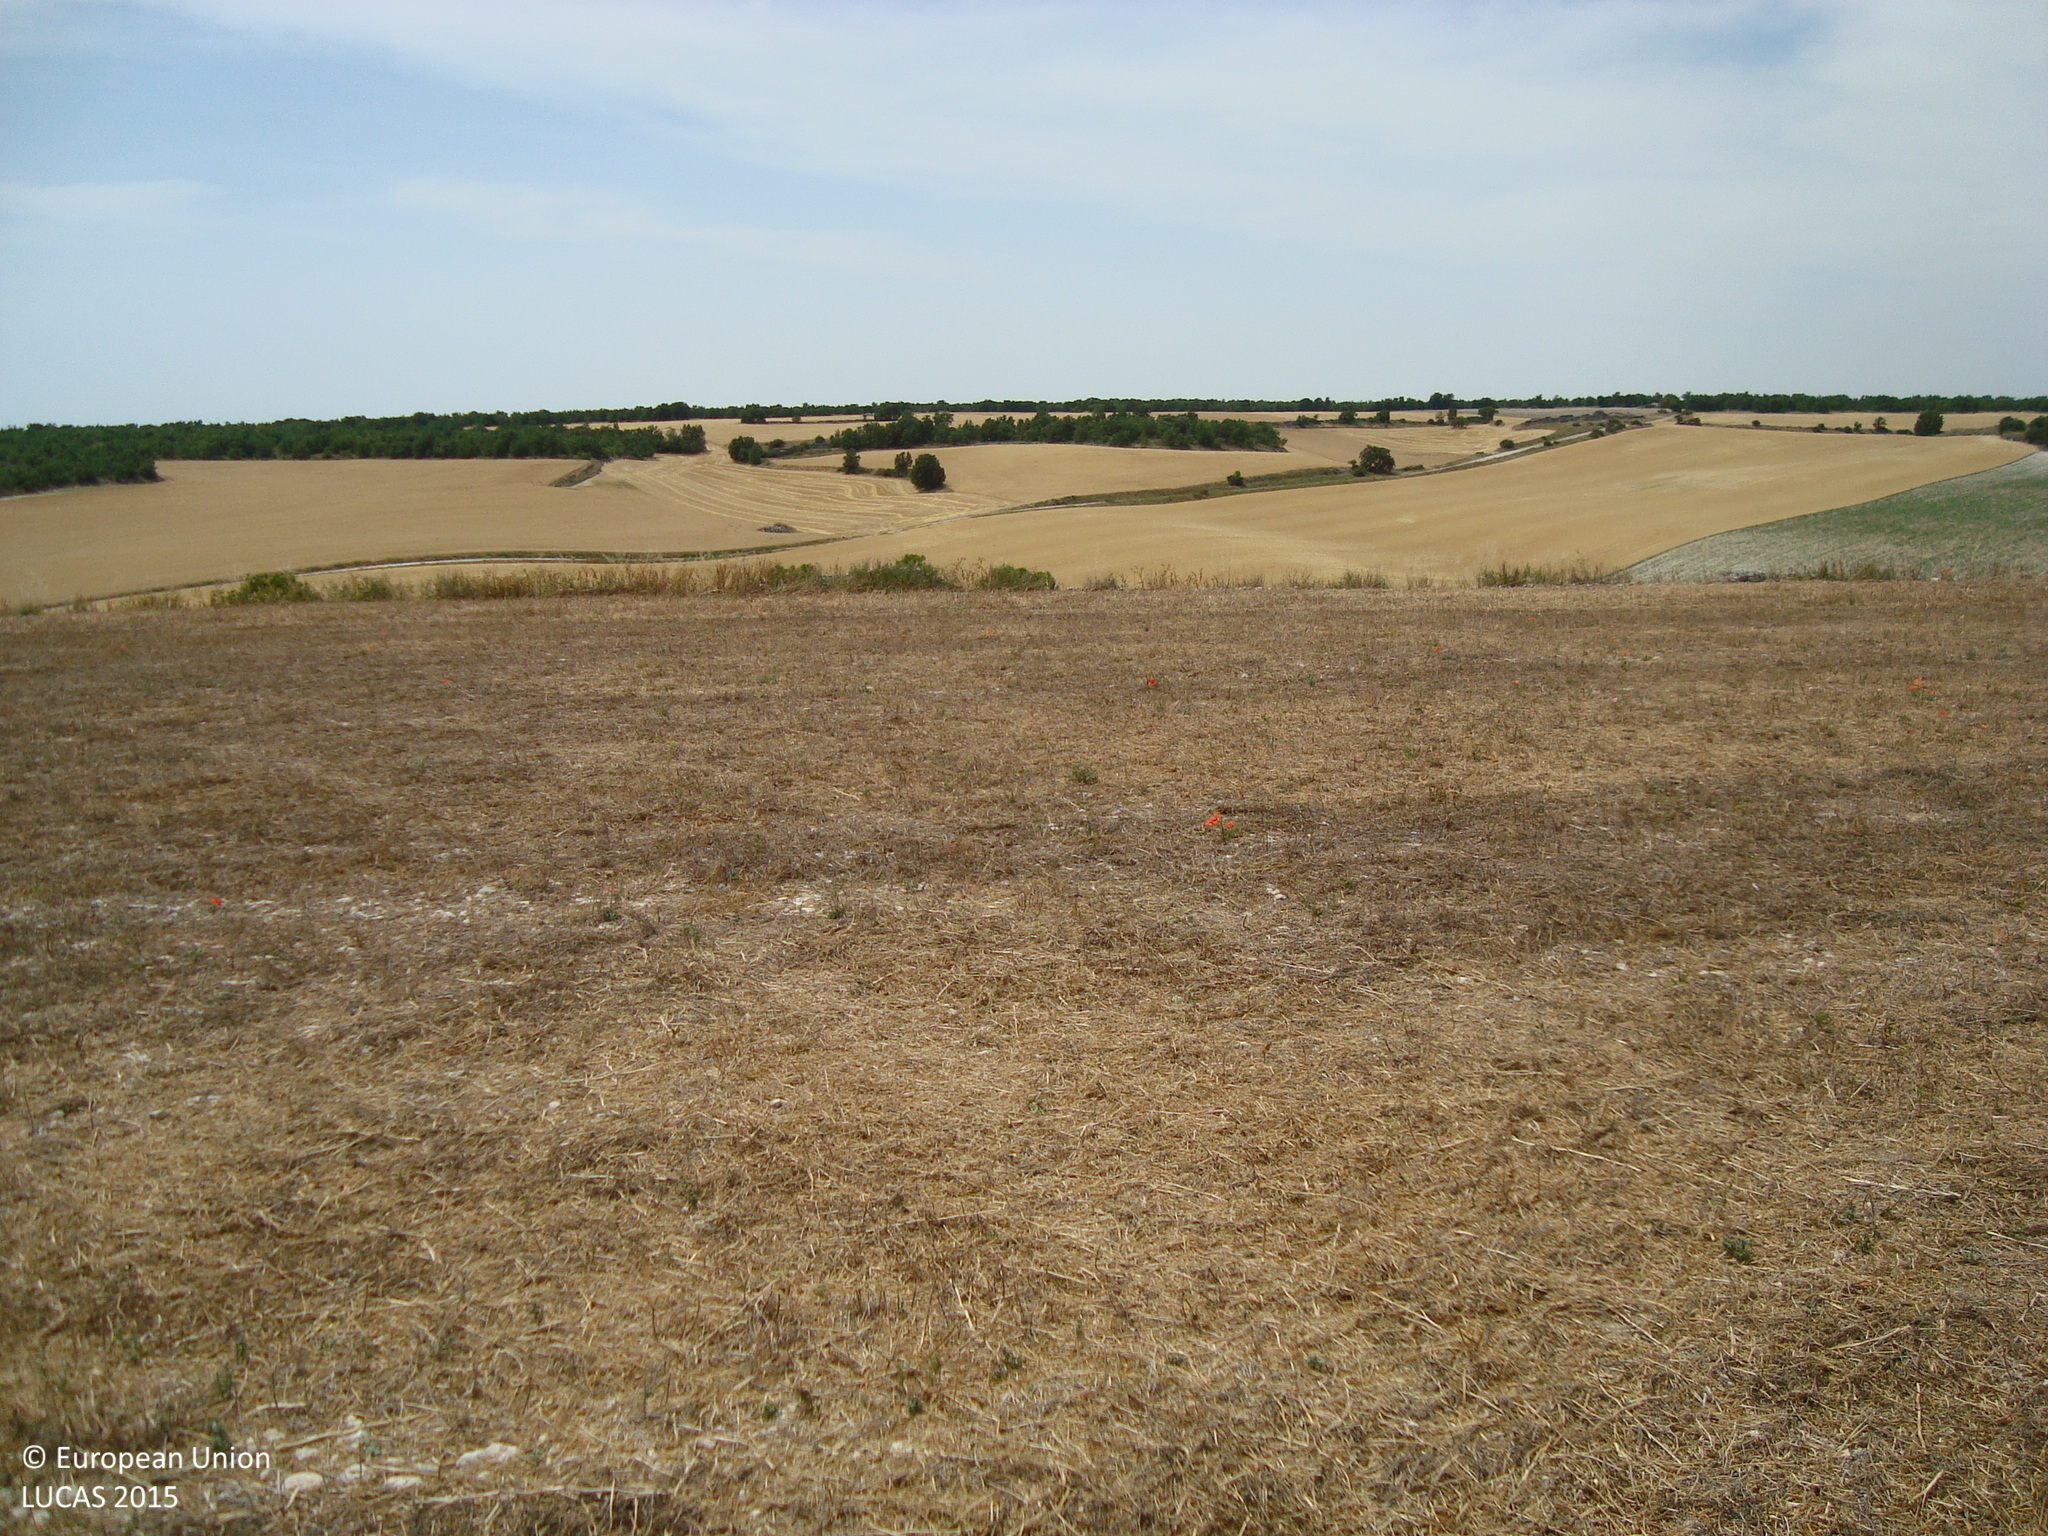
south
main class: Cropland
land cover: Dry pulses
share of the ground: < 10 %
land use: Agriculture (excluding fallow land and kitchen gardens)
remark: Harvested field
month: July
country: ES
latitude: 41.7408
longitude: -4.1896
